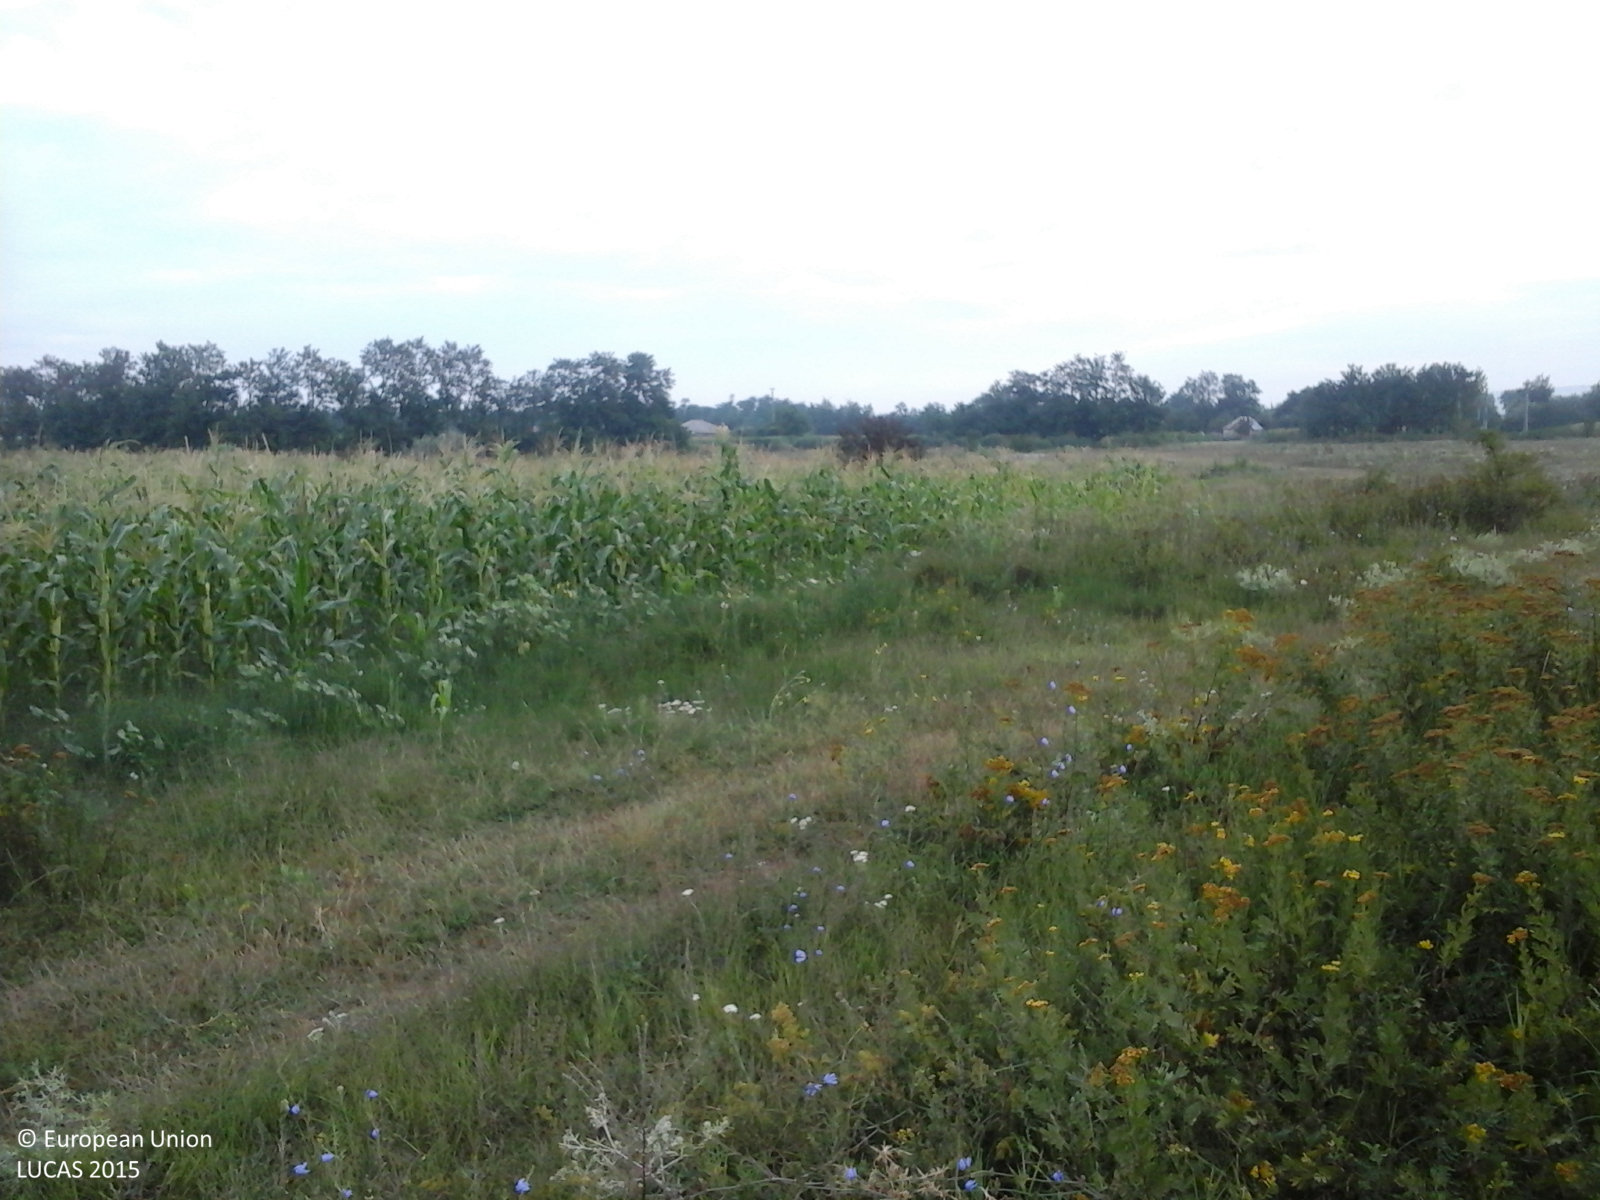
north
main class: Grassland
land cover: Spontaneously vegetated surfaces
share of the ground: > 75 %
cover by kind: herbaceous plants 100 %
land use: Fallow land
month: July
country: RO
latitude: 46.3527
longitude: 27.8055
